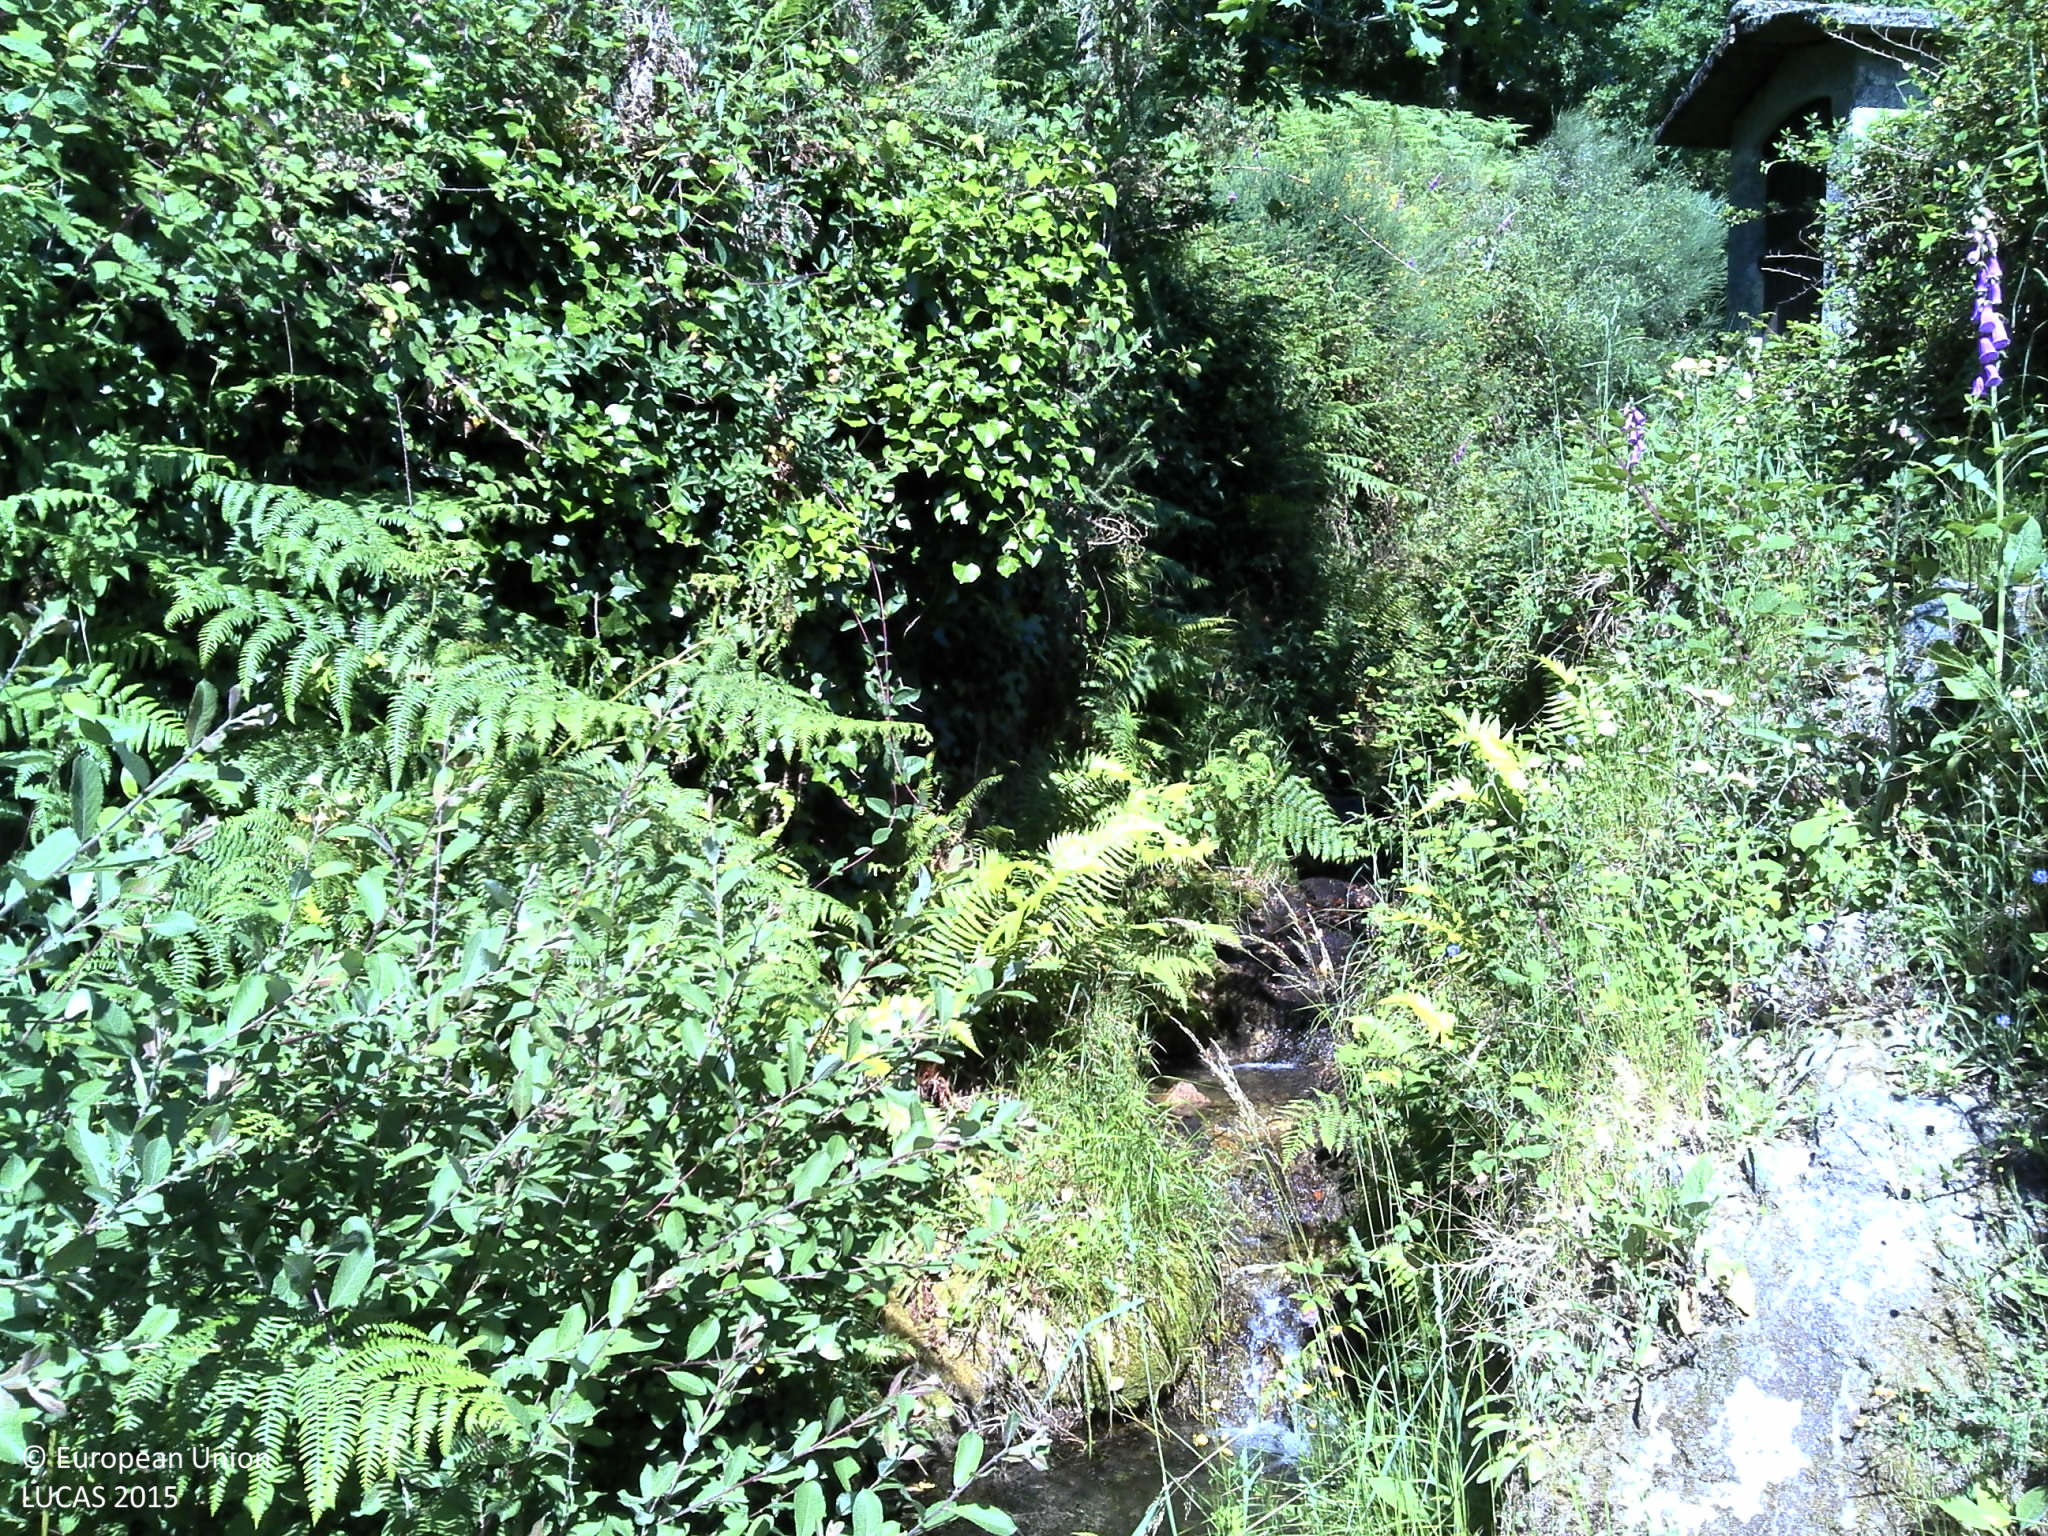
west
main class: Shrubland
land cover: Shrubland with sparse tree cover
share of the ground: 50 - 75 %
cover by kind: shrubs 60 %, unconsolidated bare surface 20 %, herbaceous plants 15 %, broadleaved forest trees 5 %
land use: Semi-natural and natural areas not in use
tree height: > 5 m
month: May
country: PT
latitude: 41.9112
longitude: -8.6982
